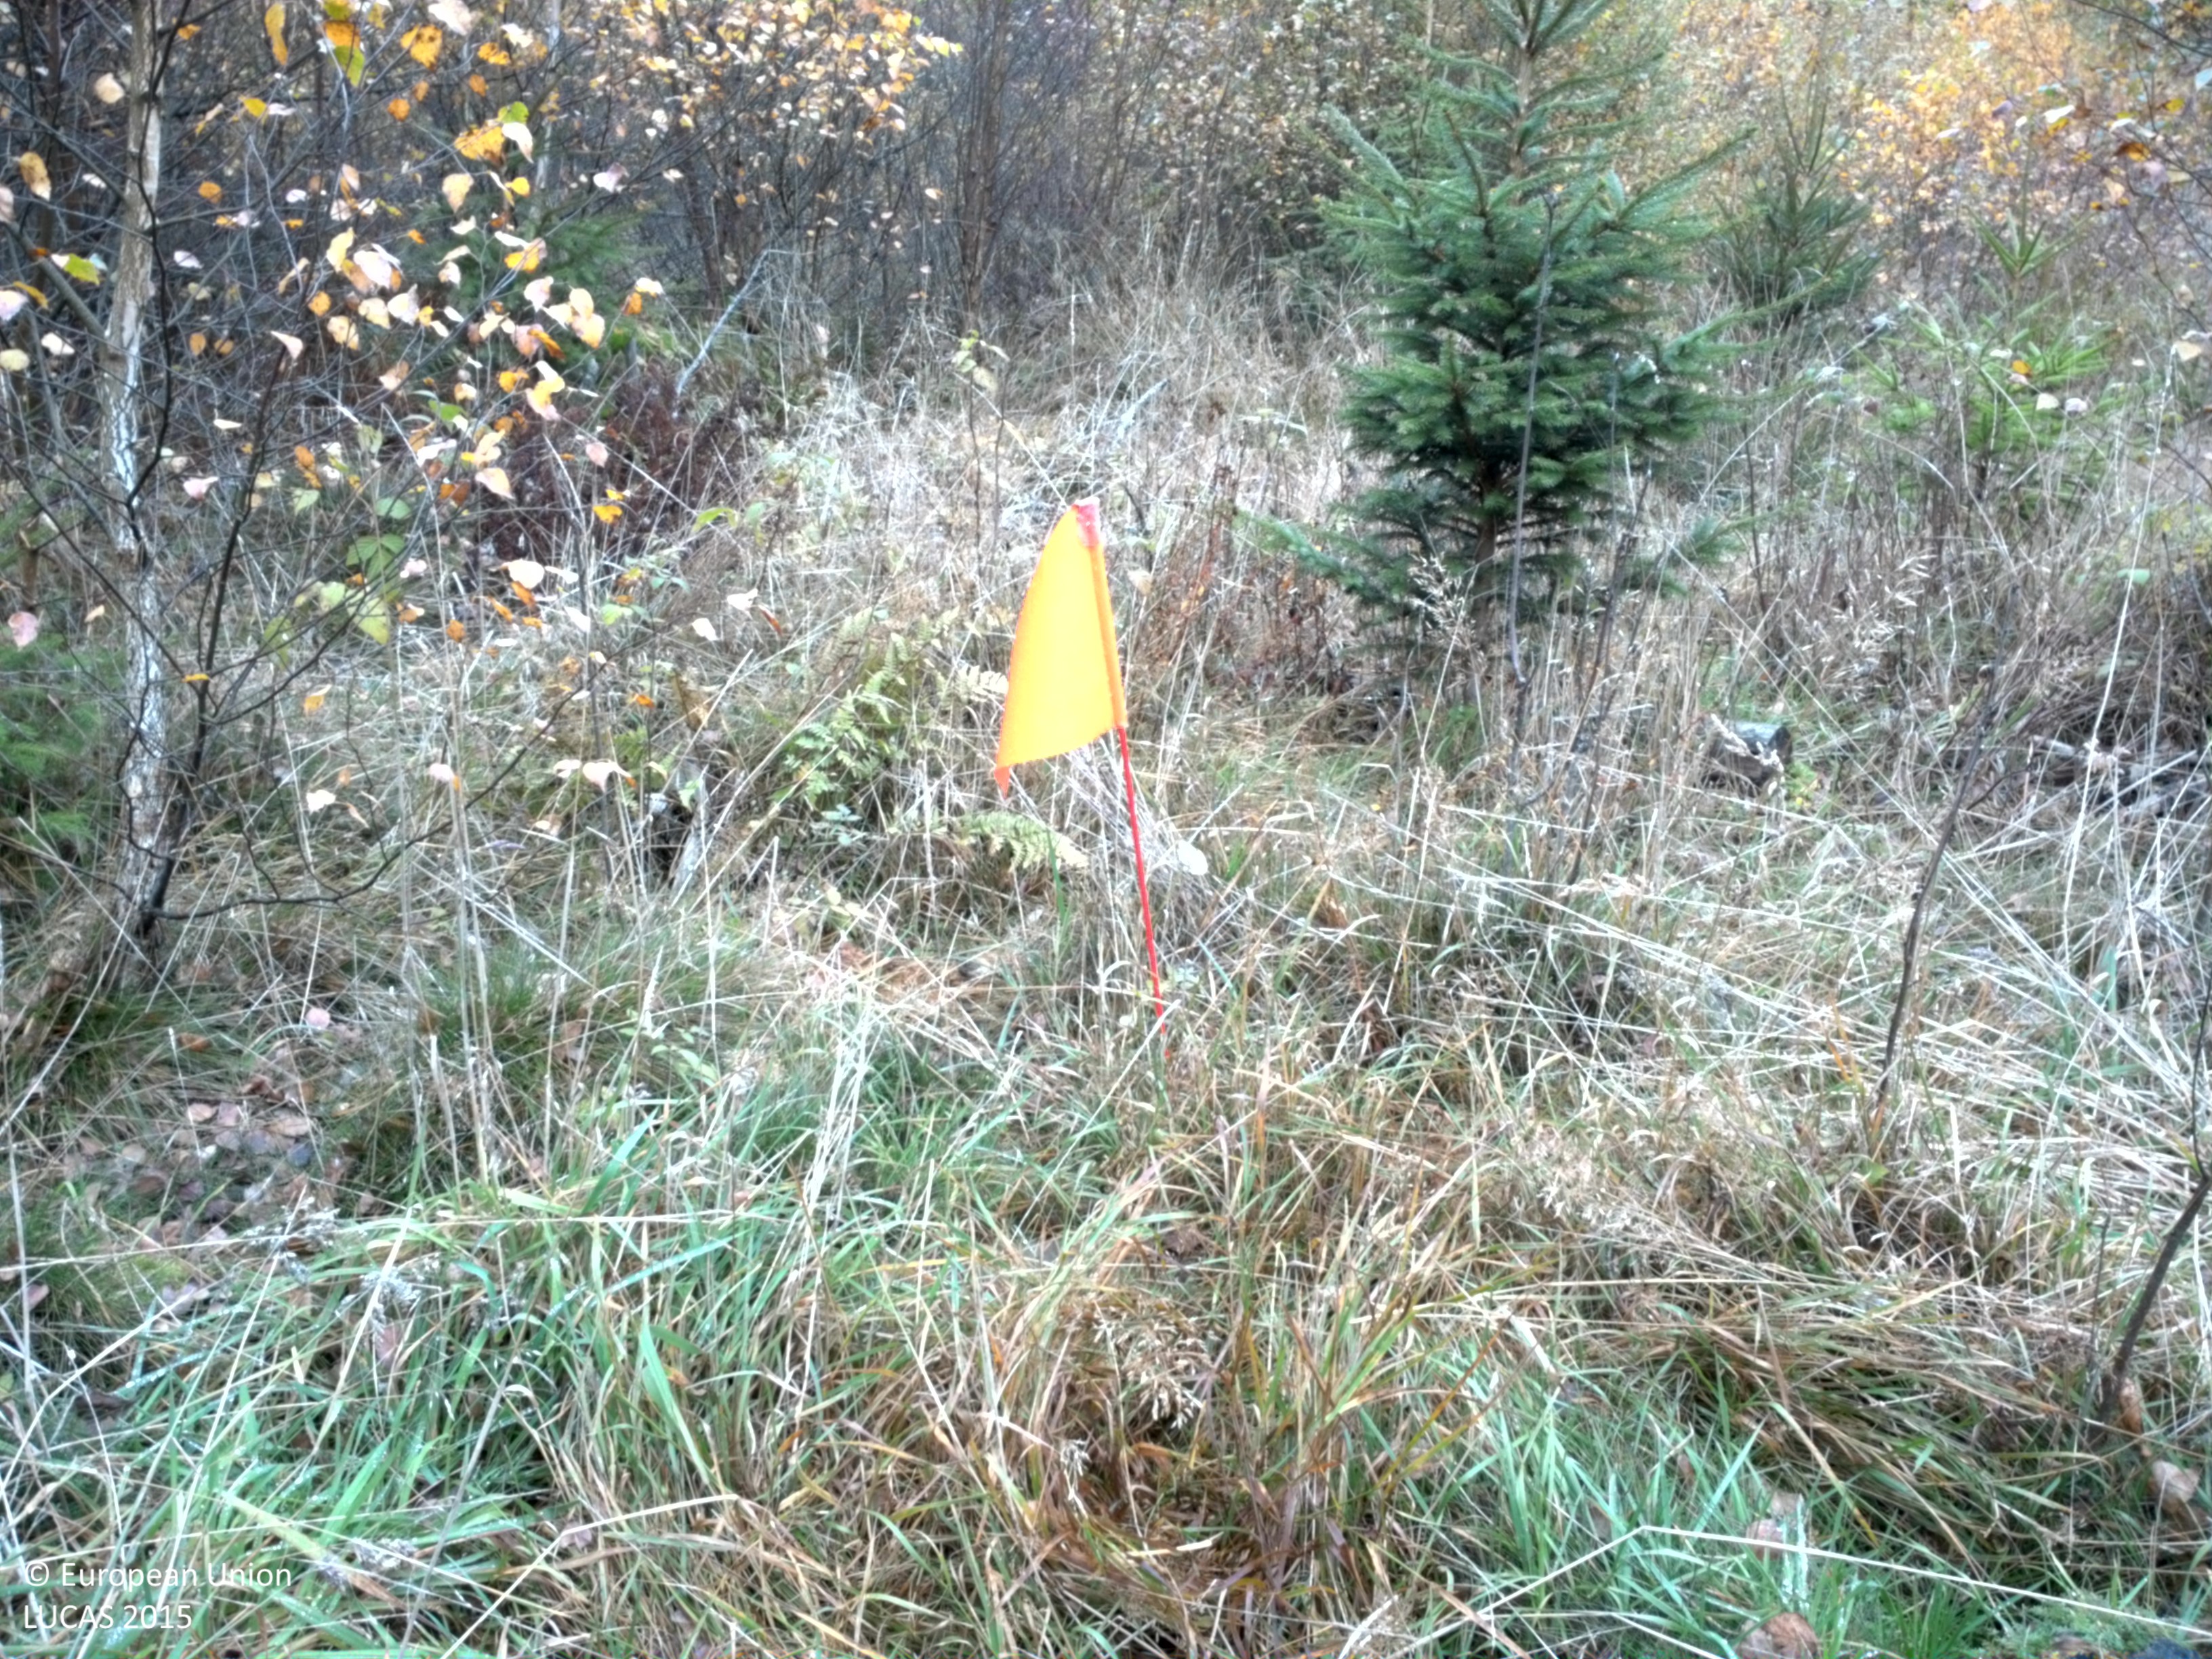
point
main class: Woodland
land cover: Other mixed woodland
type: hemiboreal forest and nemoral coniferous forest and mixed broadleaved-coniferous forest
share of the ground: 50 - 75 %
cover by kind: broadleaved forest trees 50 %, herbaceous plants 25 %, coniferous forest trees 20 %, shrubs 5 %
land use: Forestry
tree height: < 5 m
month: October
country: SE
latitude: 55.9367
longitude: 13.6958
